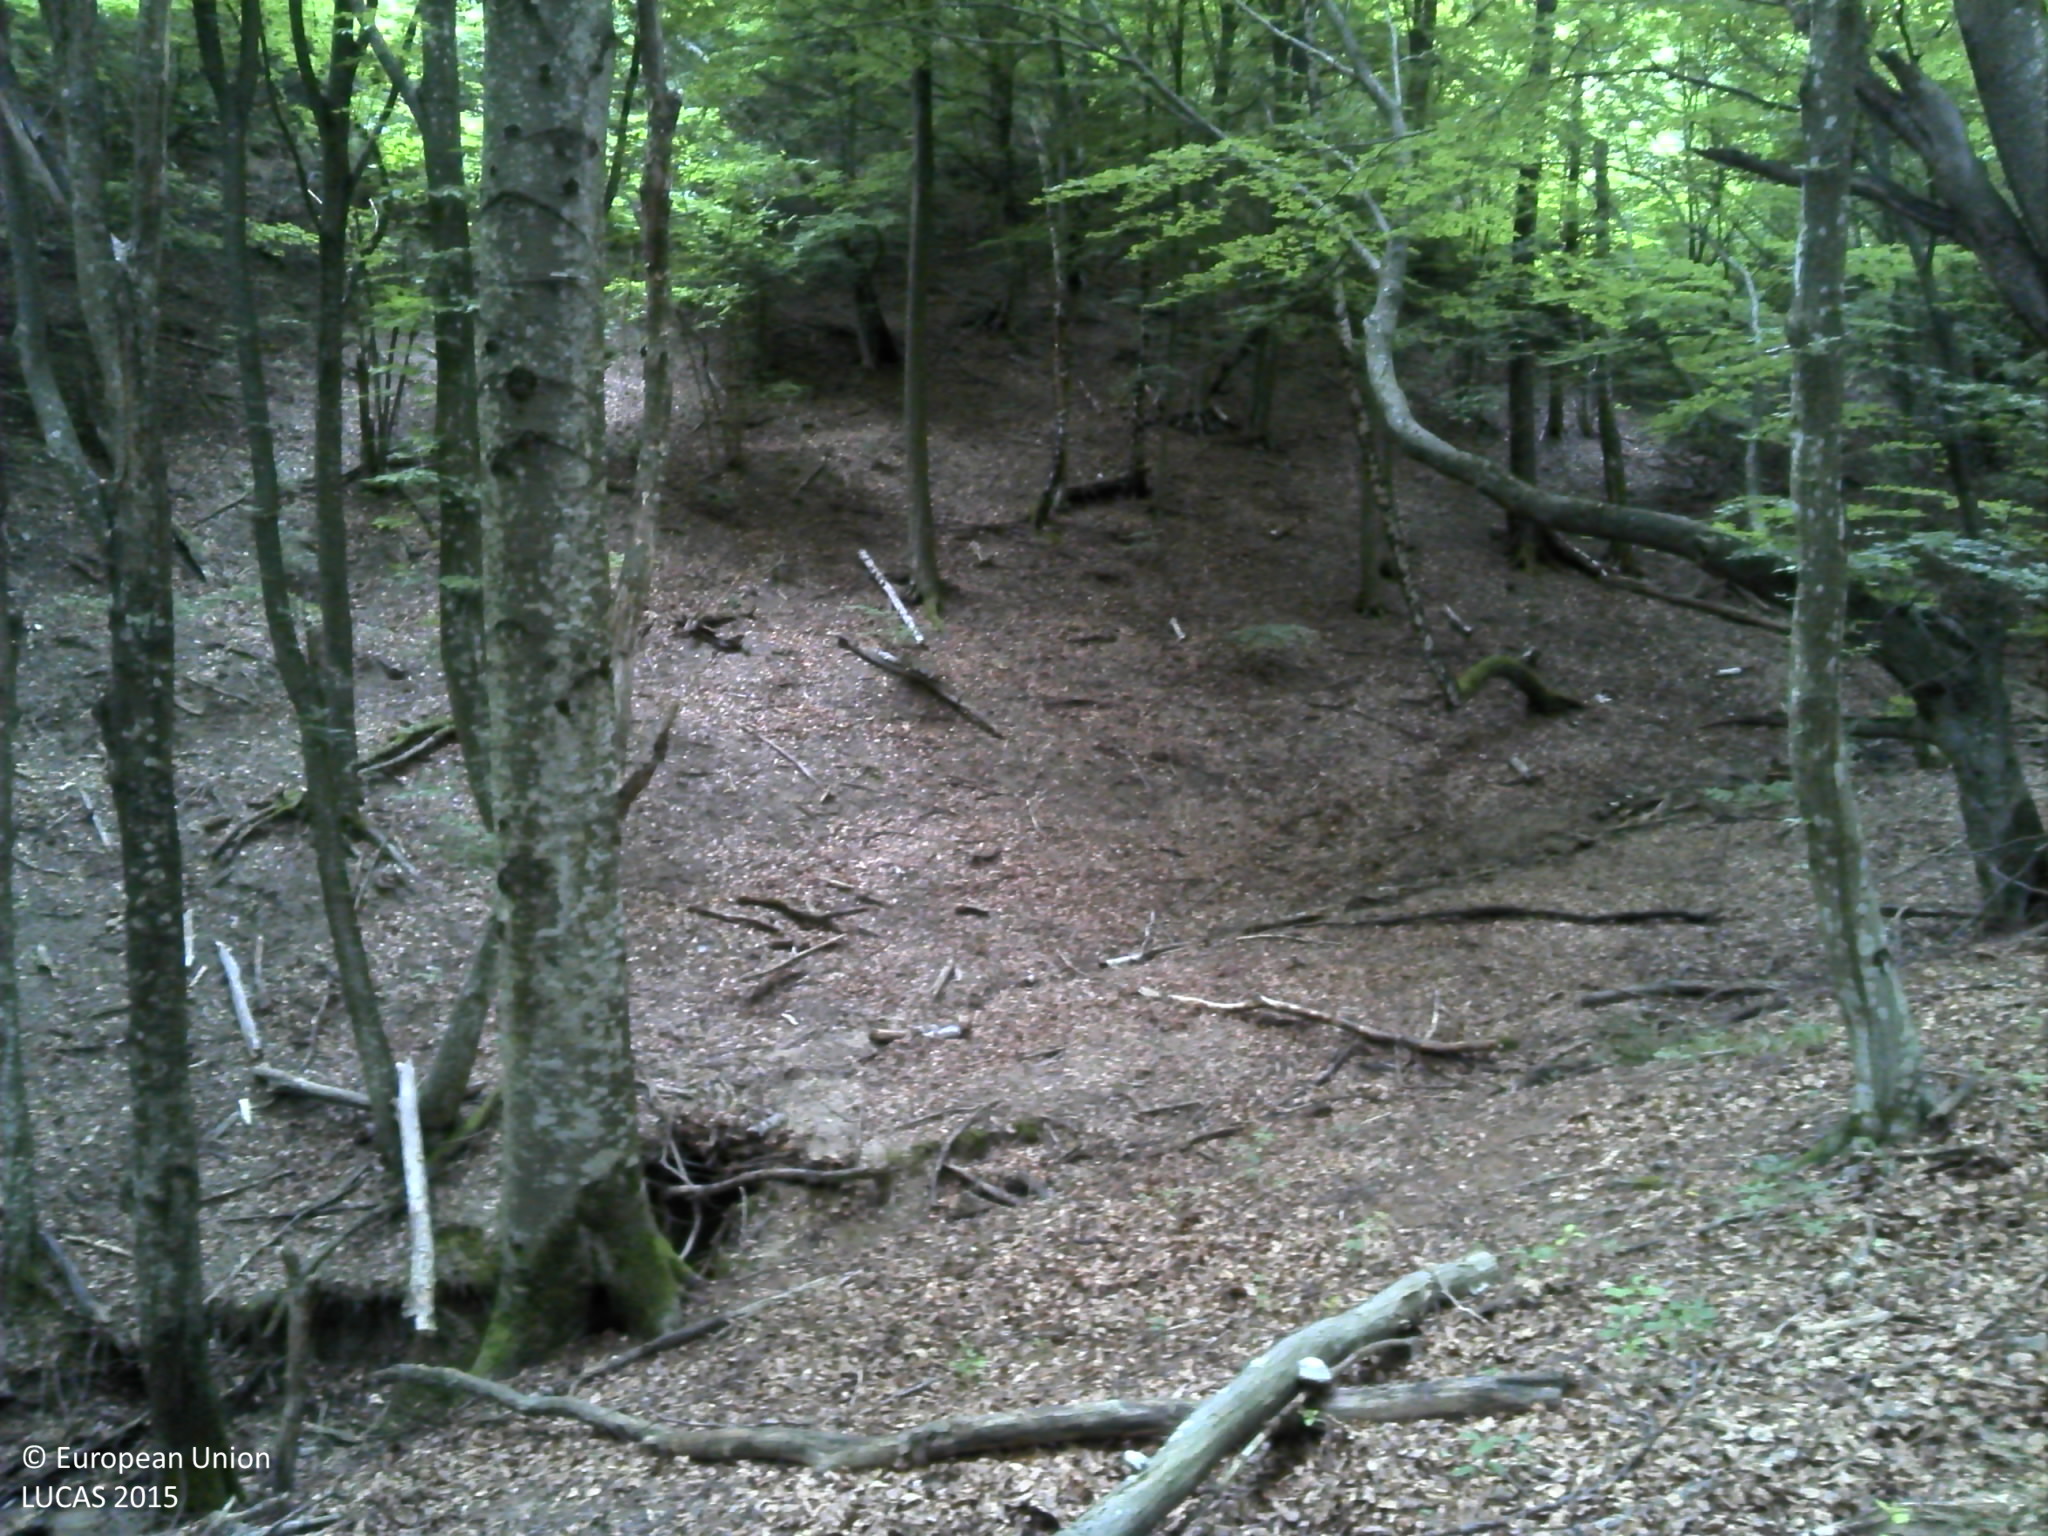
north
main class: Woodland
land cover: Broadleaved woodland
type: beech forest
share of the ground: > 75 %
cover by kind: broadleaved forest trees 100 %
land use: Forestry
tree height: > 5 m
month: June
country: HR
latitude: 45.4774
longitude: 17.4336
